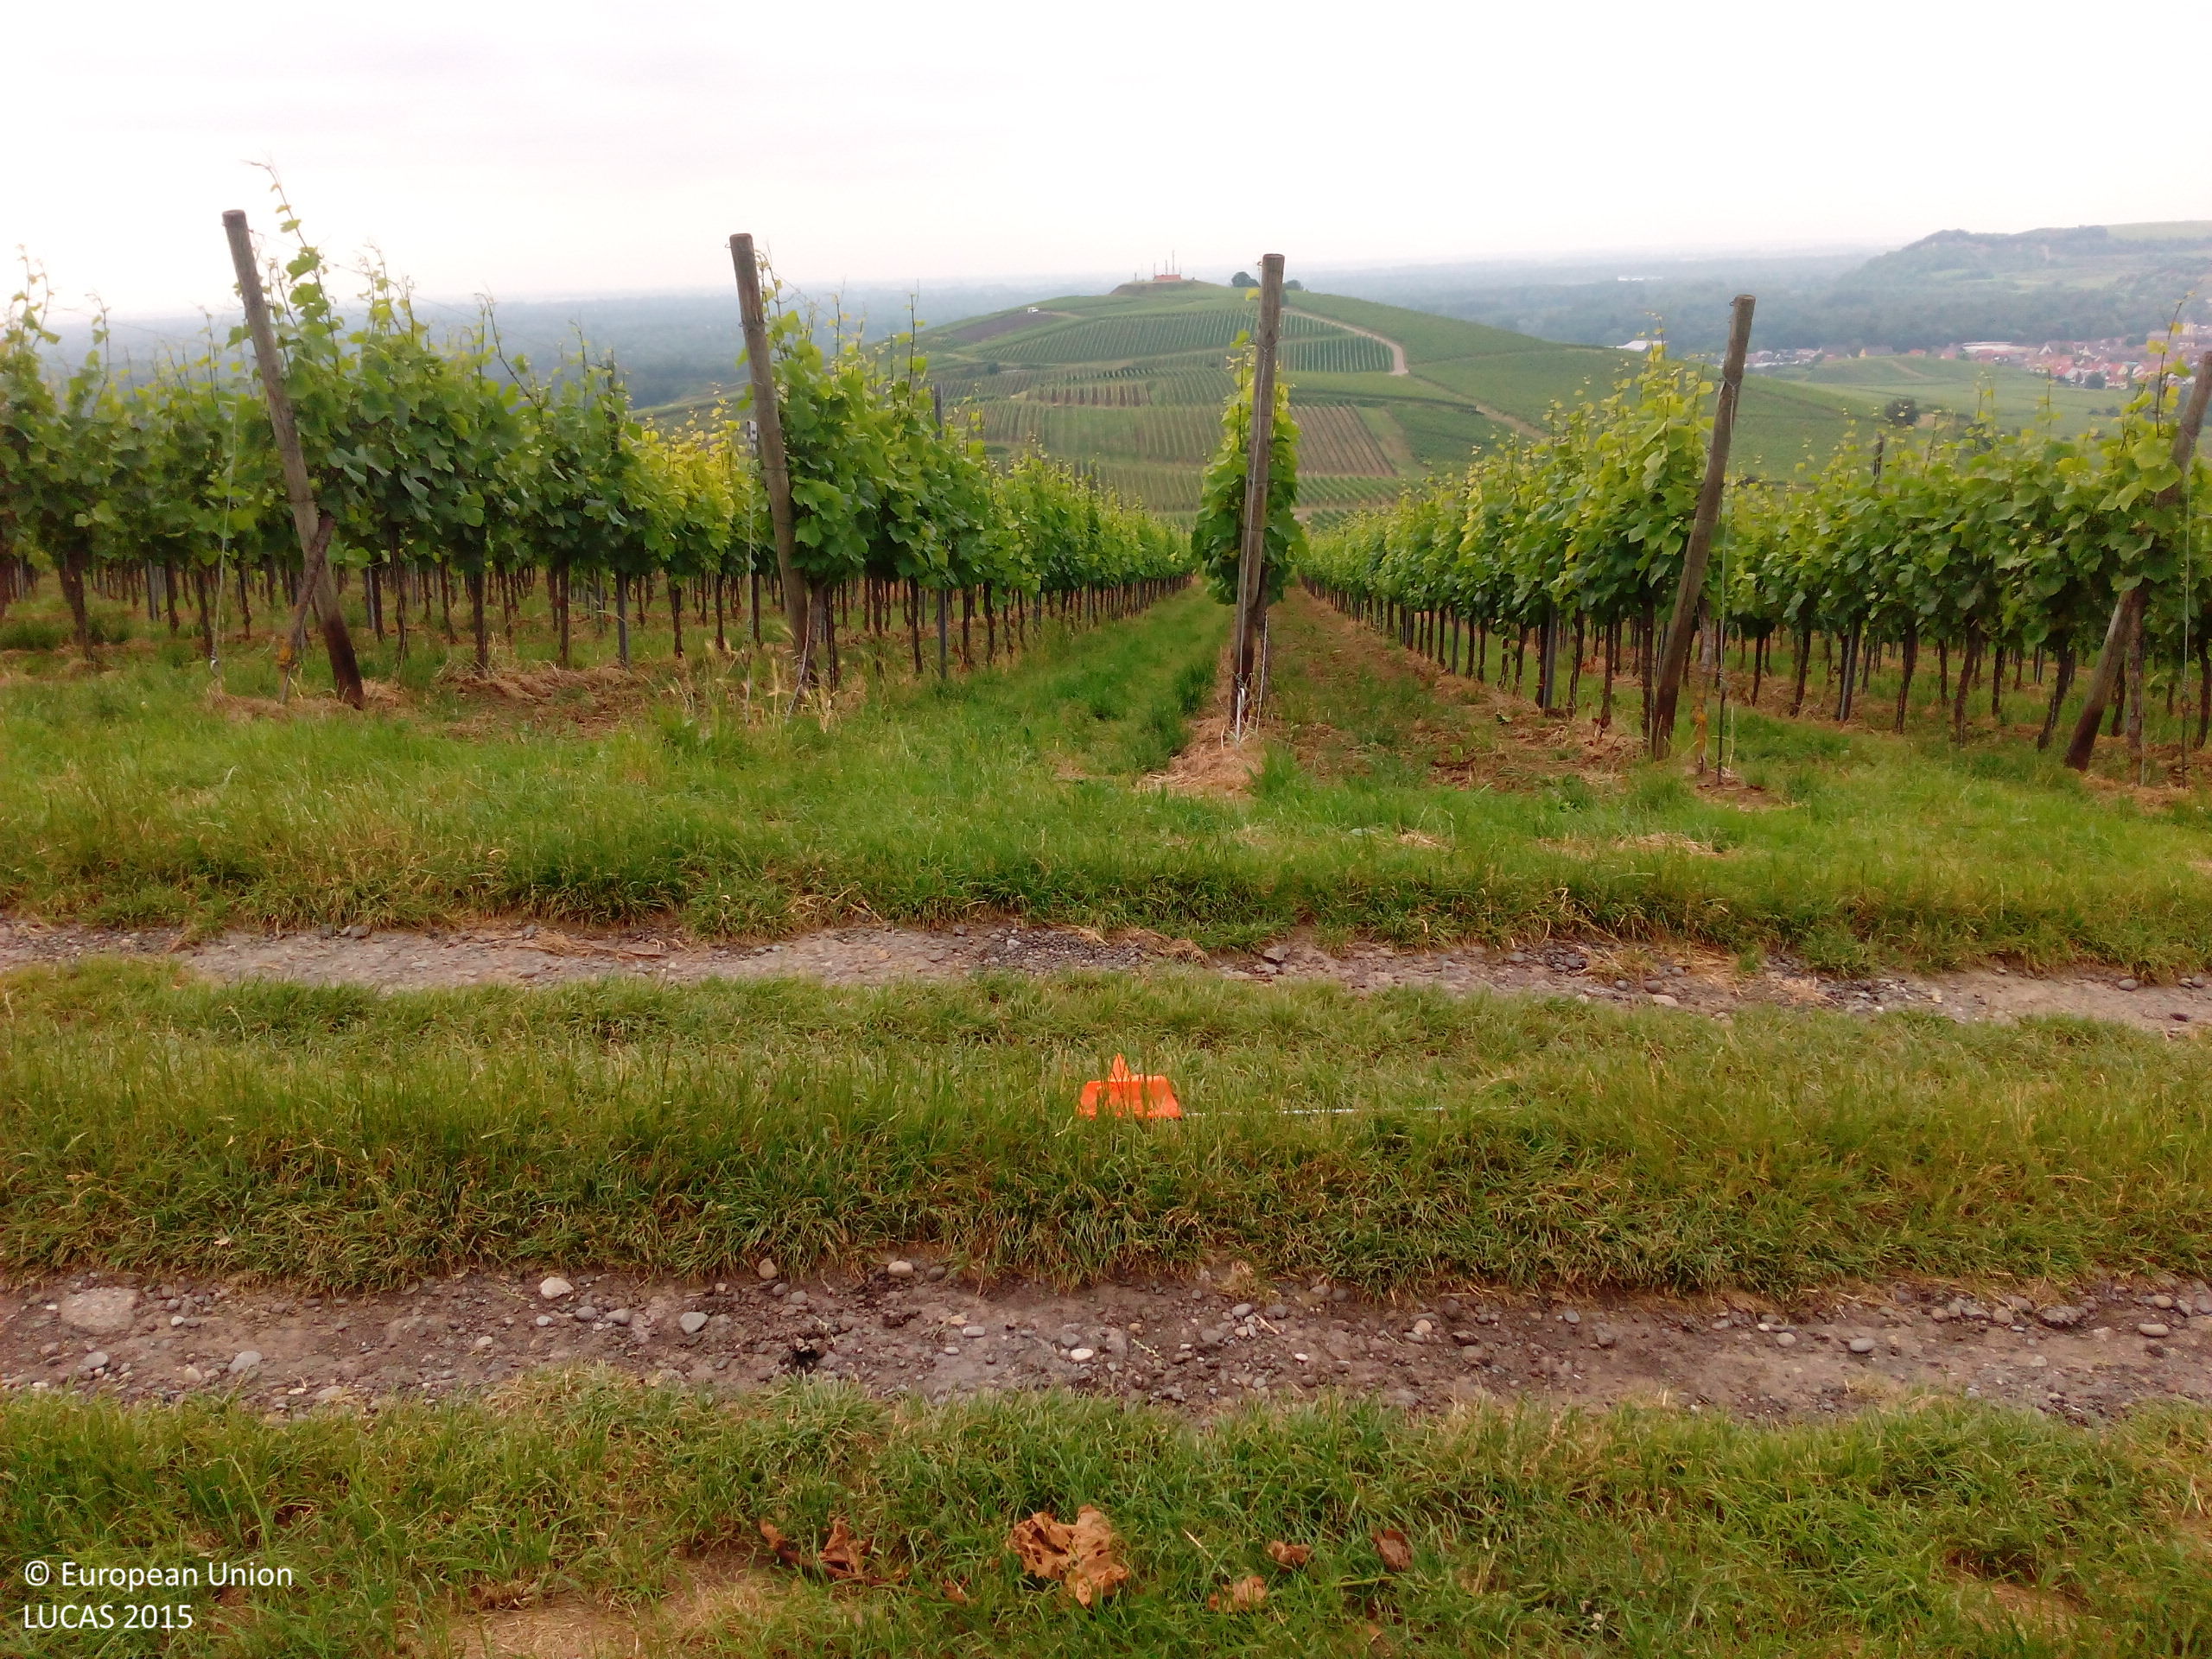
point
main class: Cropland
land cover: Vineyards
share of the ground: 25 - 50 %
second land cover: Grassland without tree/shrub cover
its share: 50 - 75 %
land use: Agriculture (excluding fallow land and kitchen gardens)
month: June
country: DE
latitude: 48.1259
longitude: 7.6231
